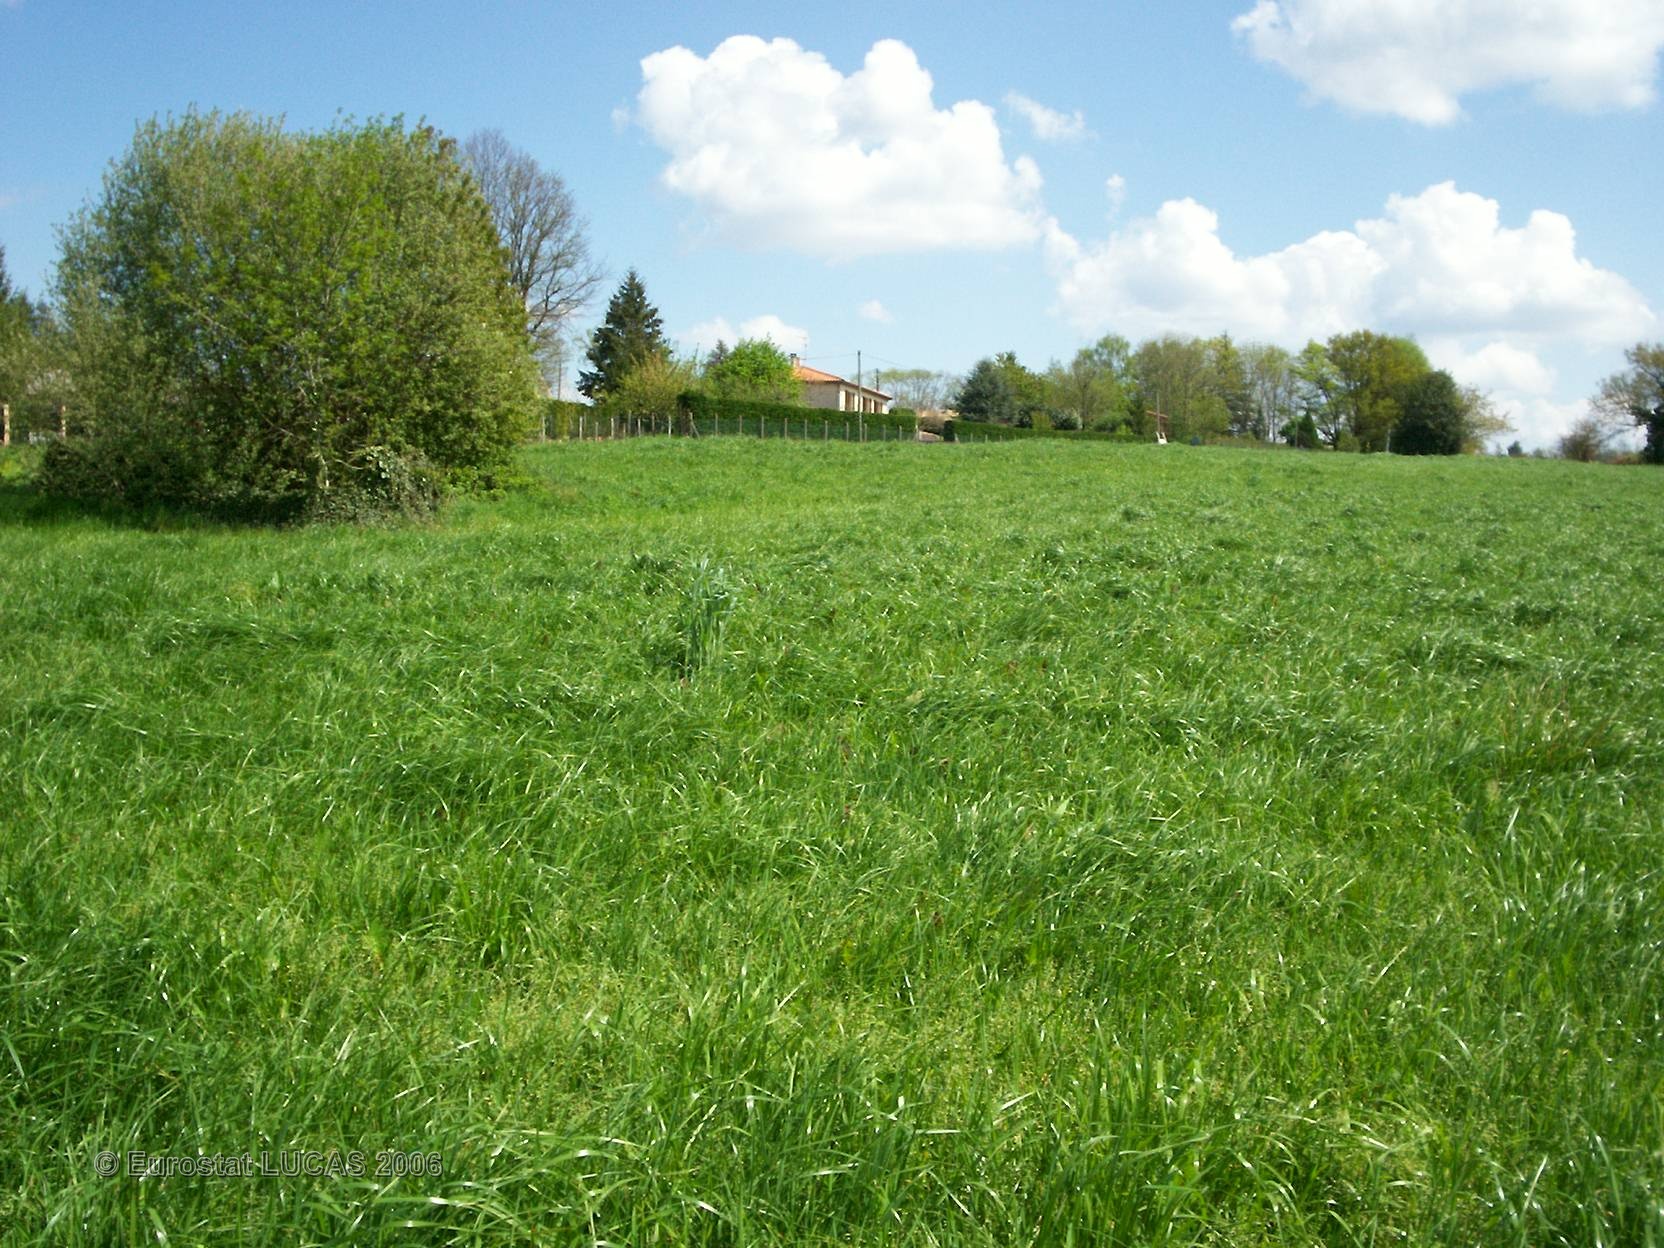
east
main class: Grassland
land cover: Grassland without tree/shrub cover
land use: Agriculture (excluding fallow land and kitchen gardens)
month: April
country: FR
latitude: 45.6761
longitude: 0.7319
